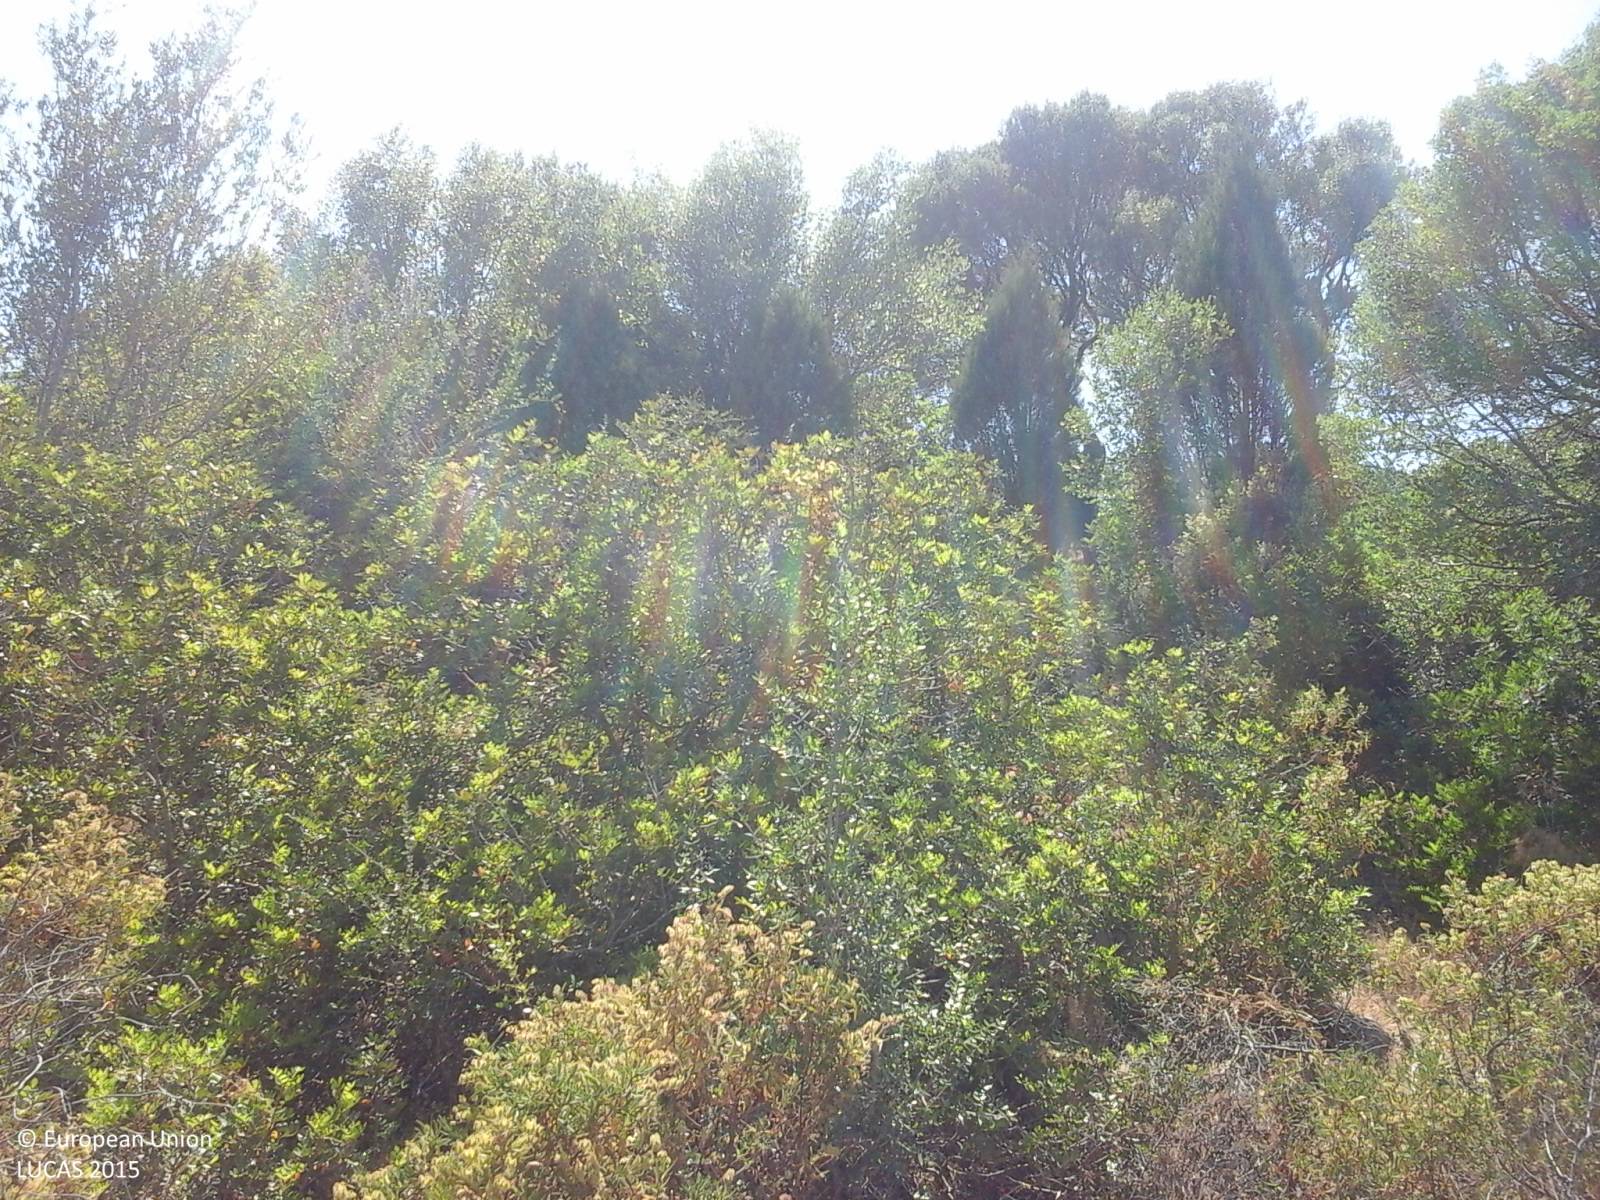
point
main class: Shrubland
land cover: Shrubland with sparse tree cover
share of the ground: 25 - 50 %
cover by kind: shrubs 70 %, herbaceous plants 25 %, broadleaved forest trees 5 %
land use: Agriculture (excluding fallow land and kitchen gardens)
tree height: > 5 m
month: June
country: IT
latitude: 38.9201
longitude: 8.8655
